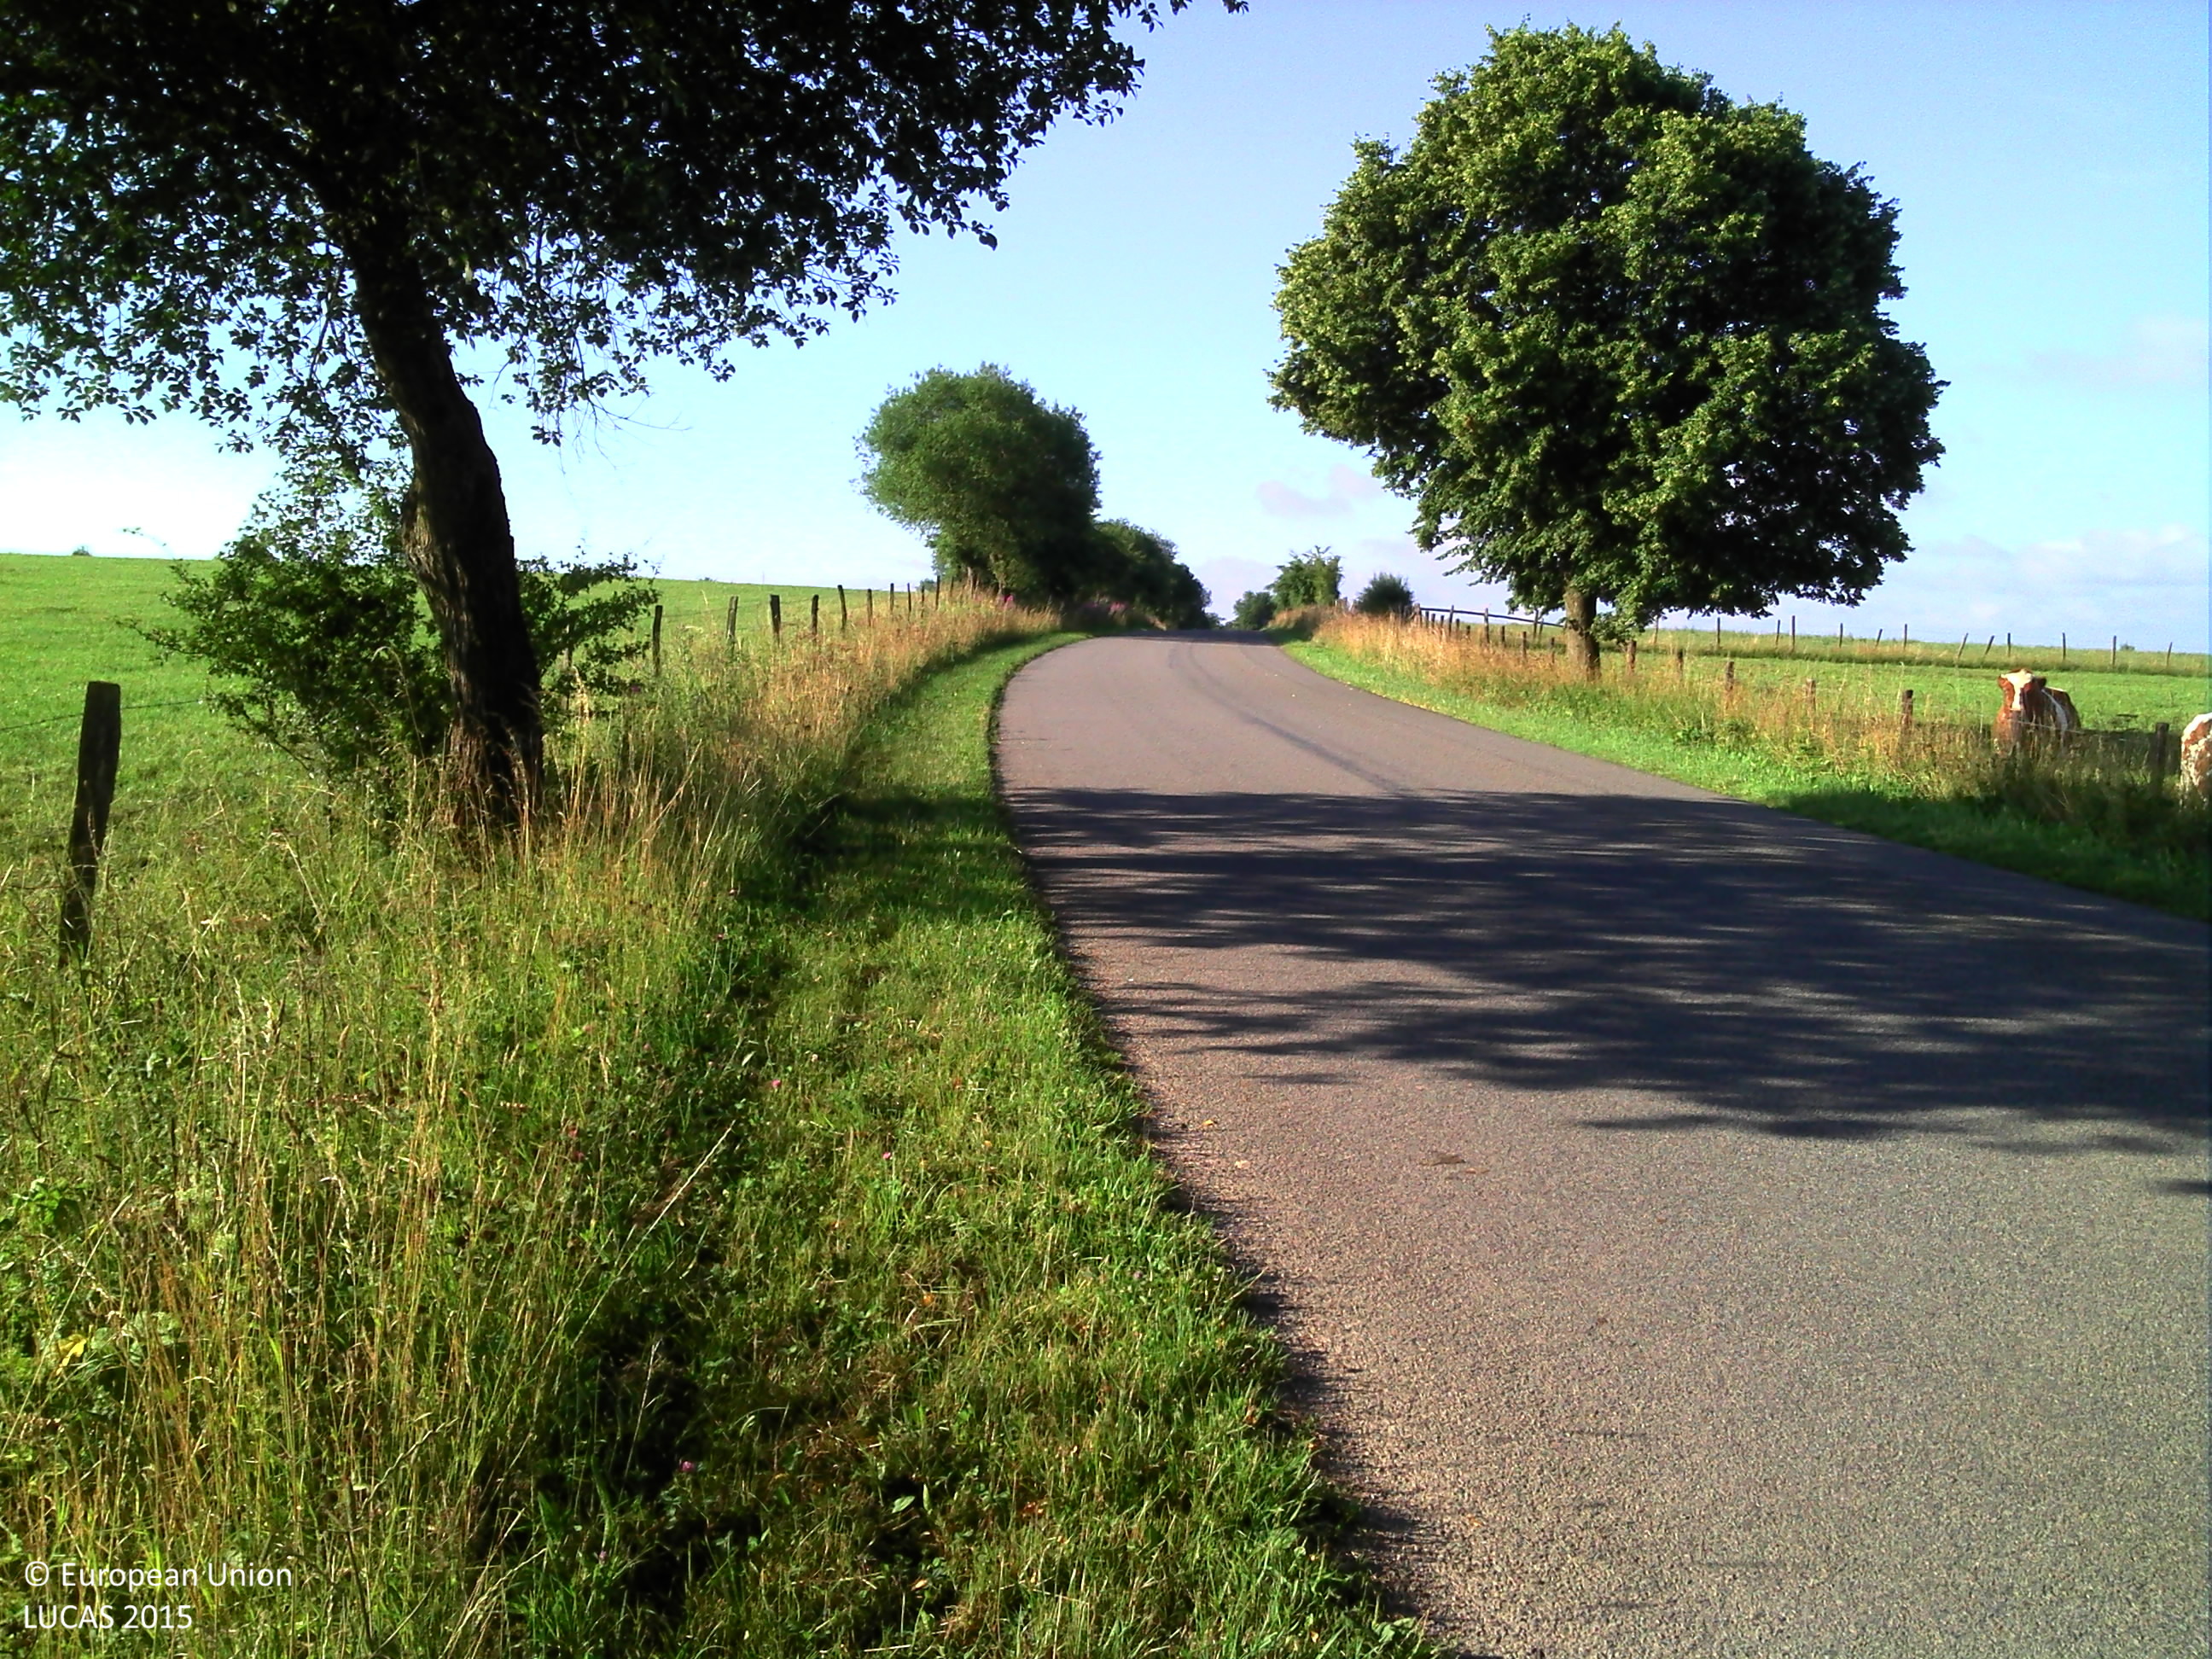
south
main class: Grassland
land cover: Grassland without tree/shrub cover
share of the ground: > 75 %
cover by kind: herbaceous plants 100 %
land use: Agriculture (excluding fallow land and kitchen gardens)
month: July
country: BE
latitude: 50.3735
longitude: 6.2170
